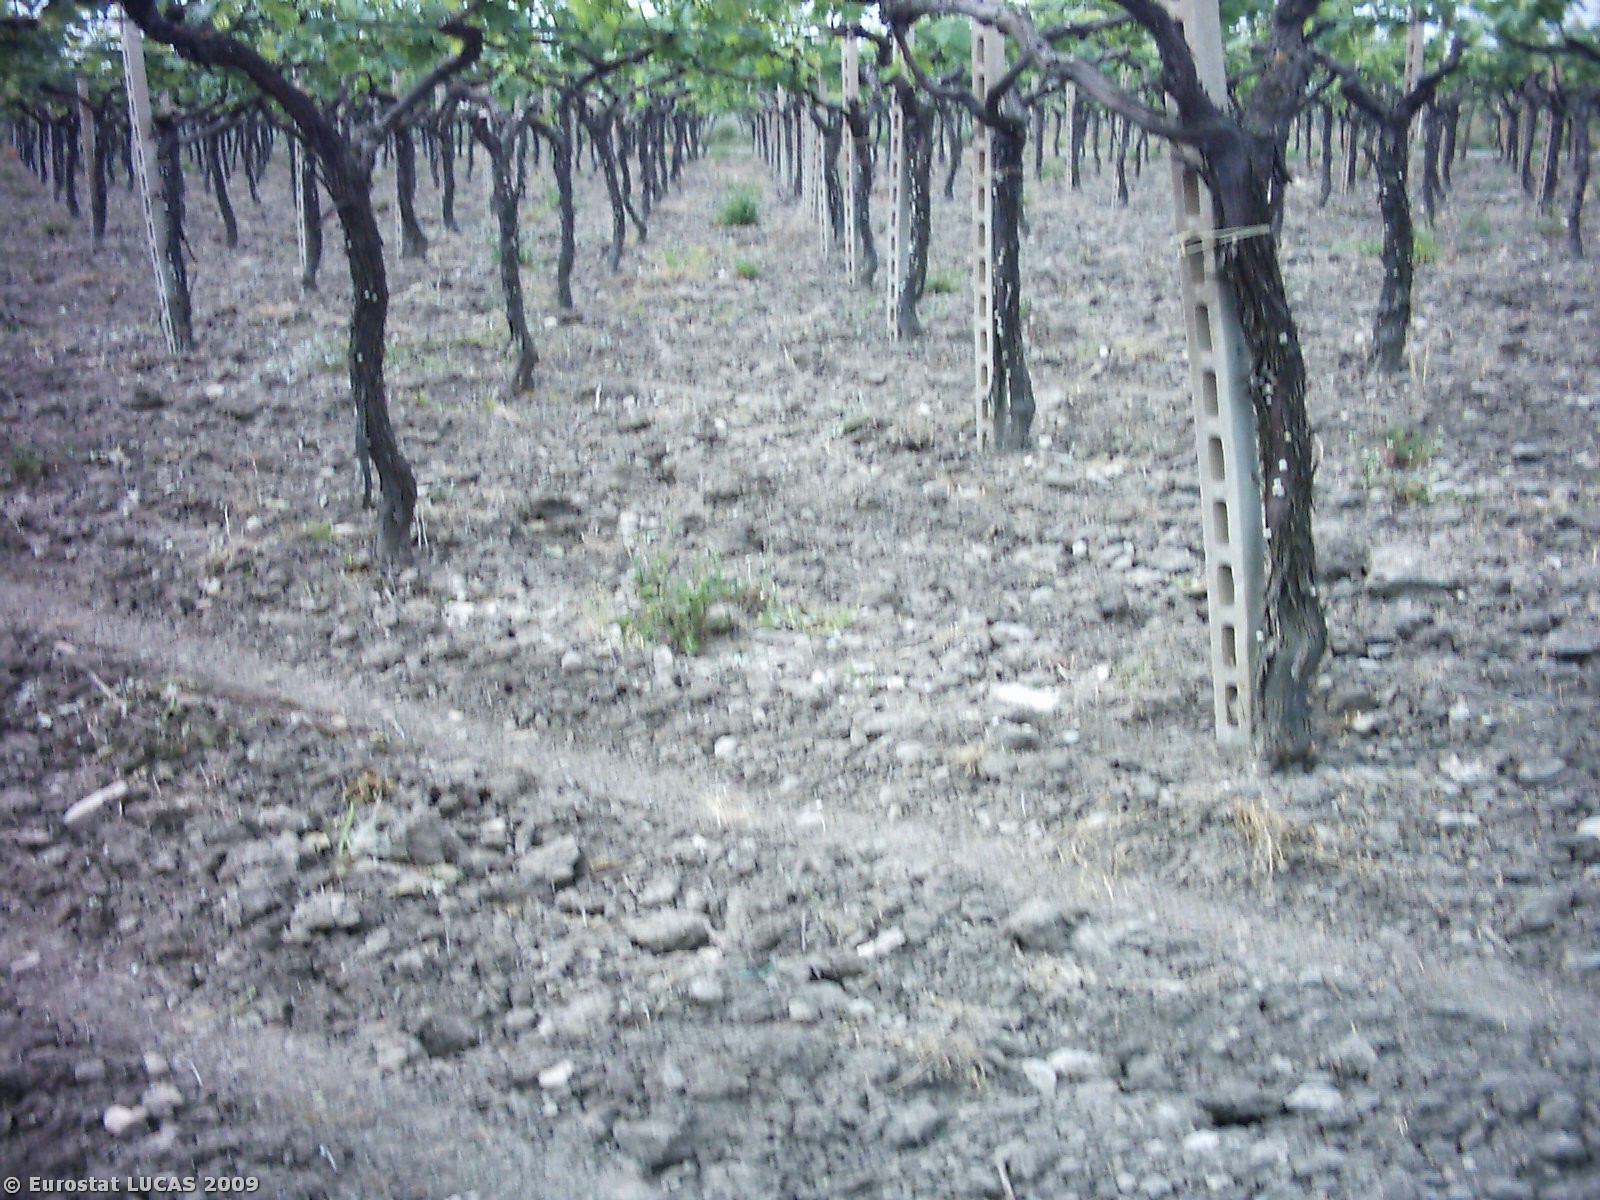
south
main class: Cropland
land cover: Vineyards
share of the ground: 50 - 75 %
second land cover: Bare land
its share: > 75 %
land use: Agriculture (excluding fallow land and kitchen gardens)
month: May
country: IT
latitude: 41.4824
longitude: 15.6466
